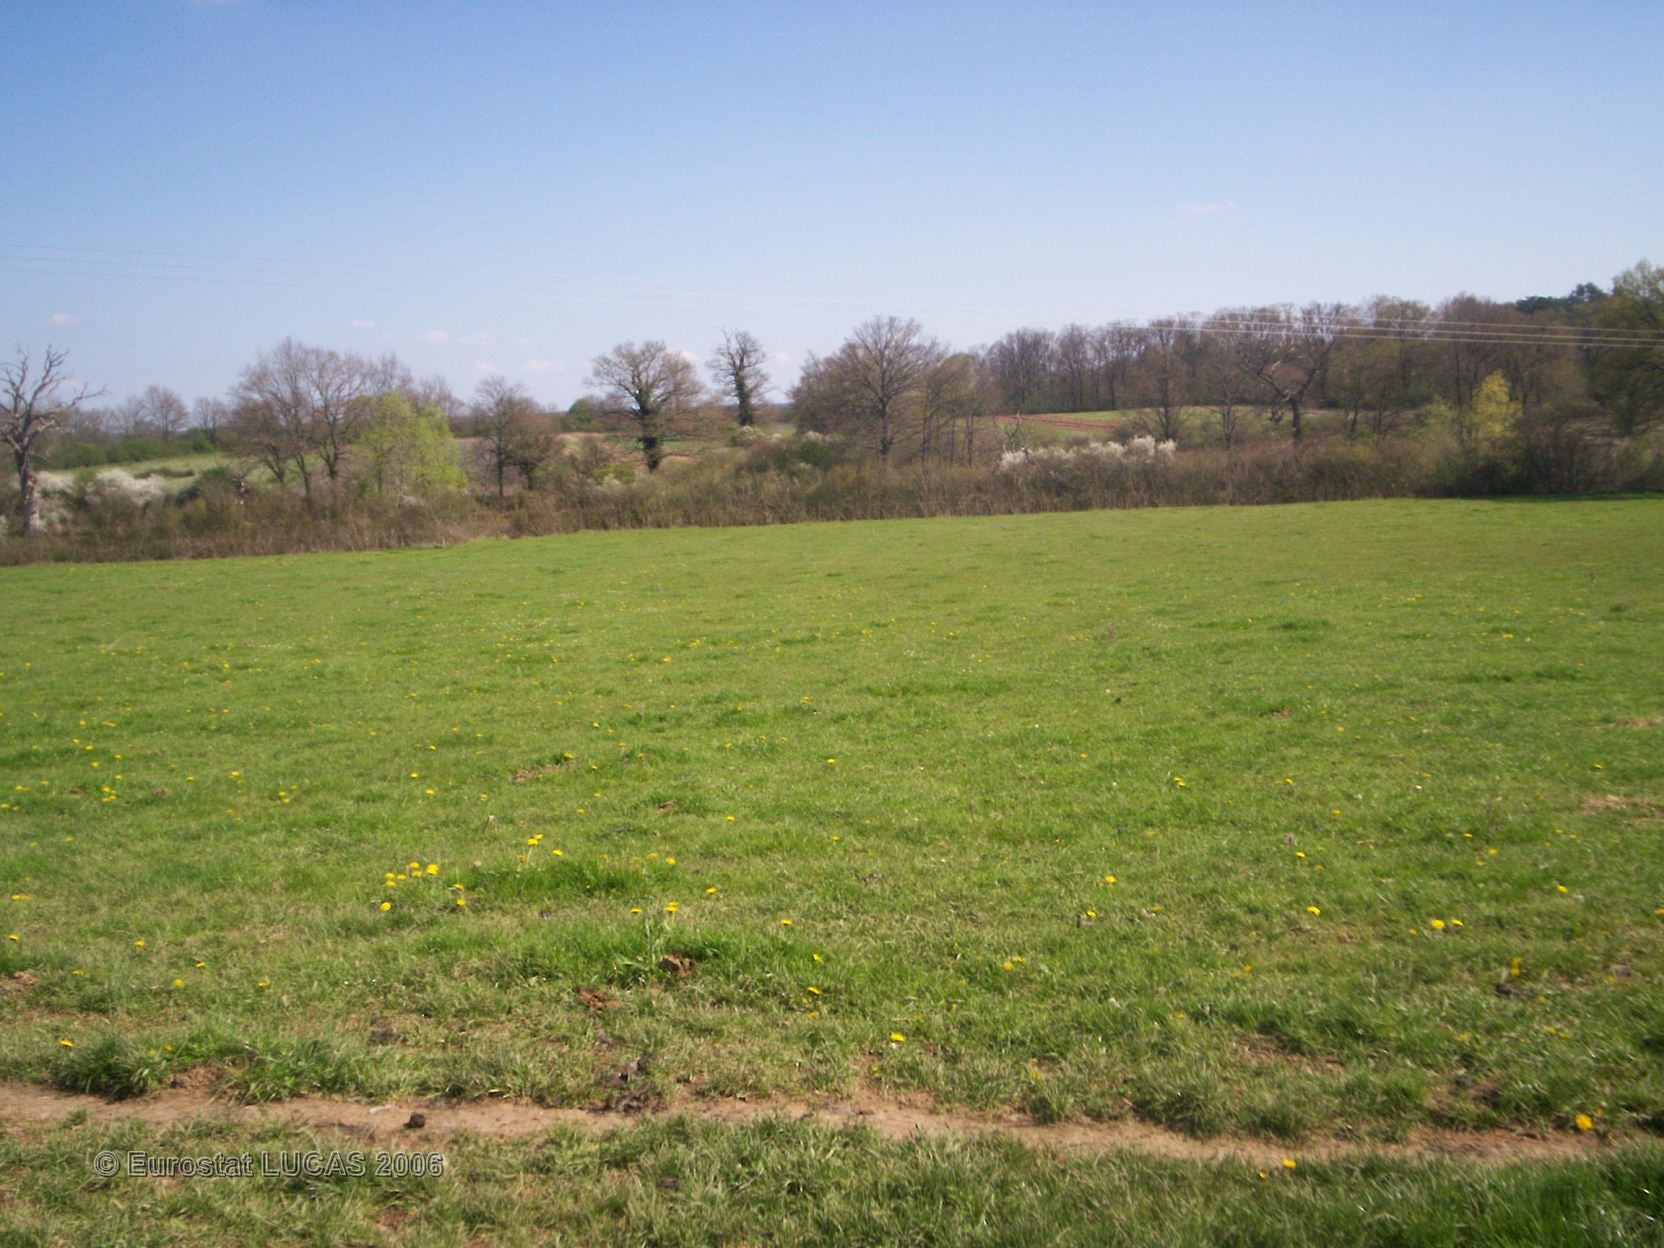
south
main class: Grassland
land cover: Grassland without tree/shrub cover
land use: Agriculture (excluding fallow land and kitchen gardens)
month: April
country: FR
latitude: 46.6189
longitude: 3.1415
